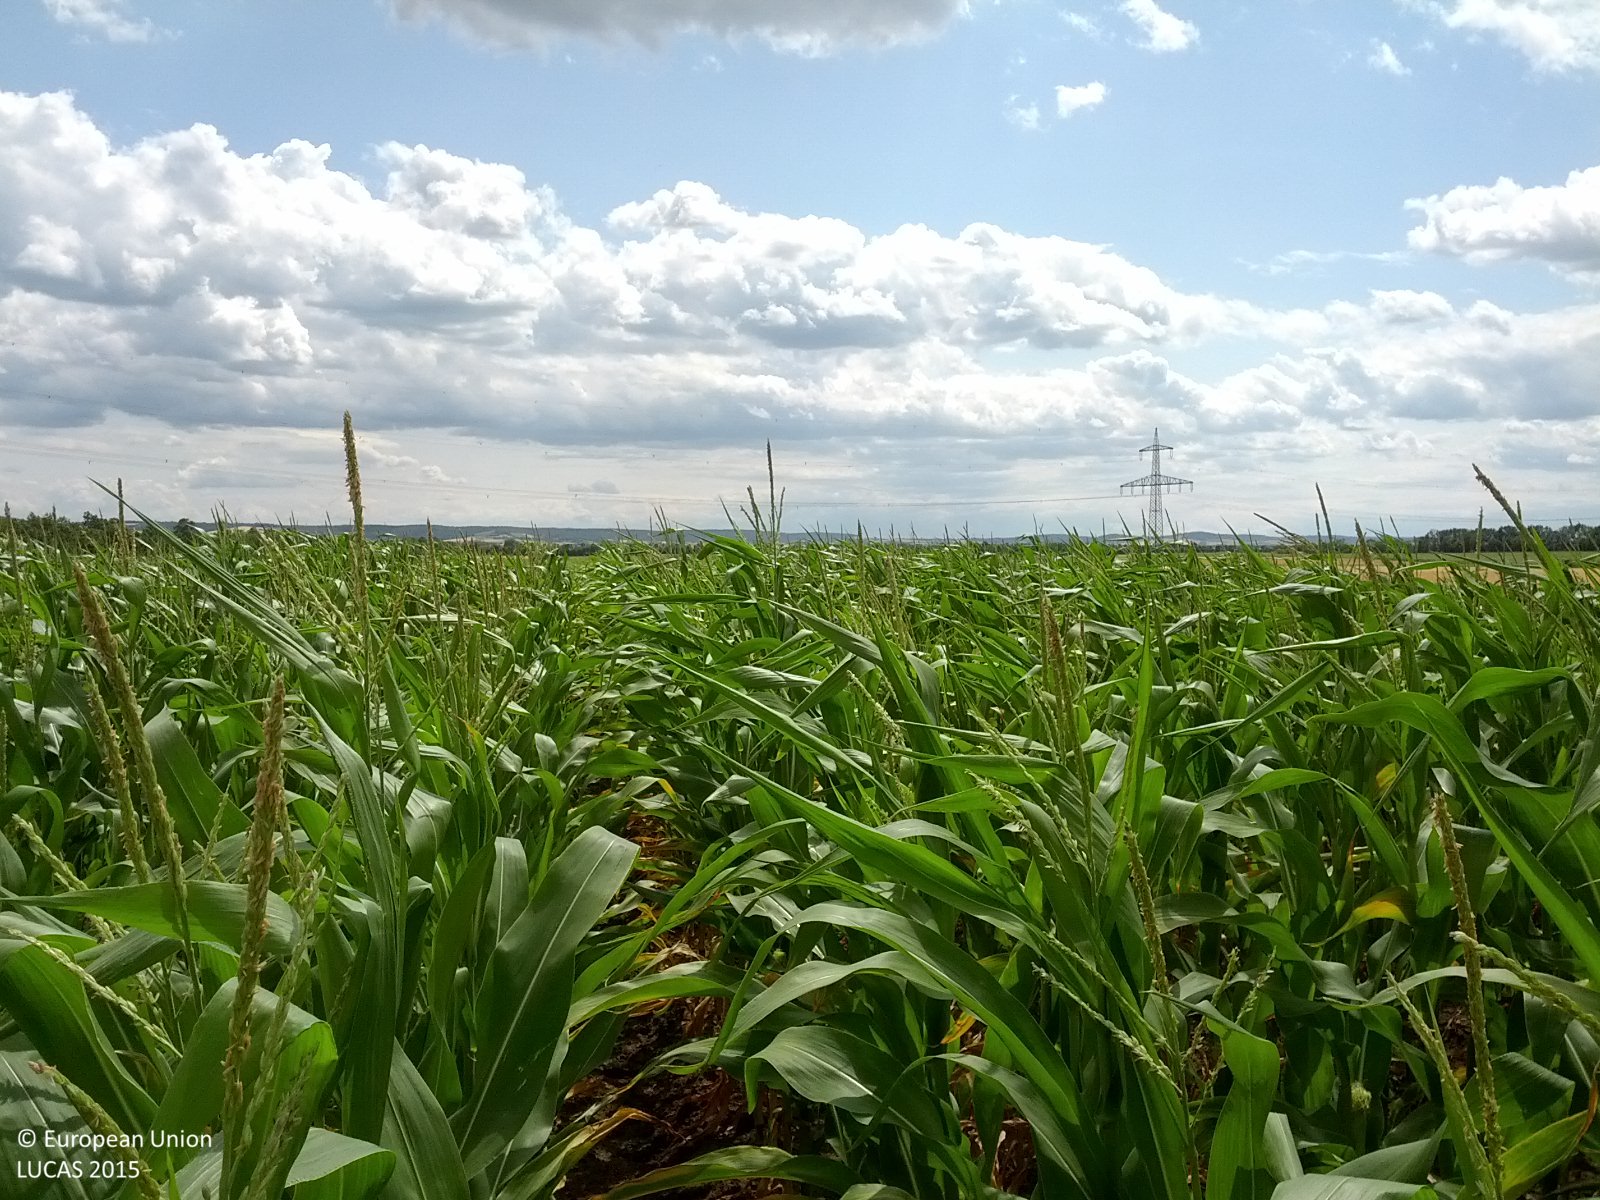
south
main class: Cropland
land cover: Maize
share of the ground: > 75 %
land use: Agriculture (excluding fallow land and kitchen gardens)
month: July
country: AT
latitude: 48.7112
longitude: 16.2979
